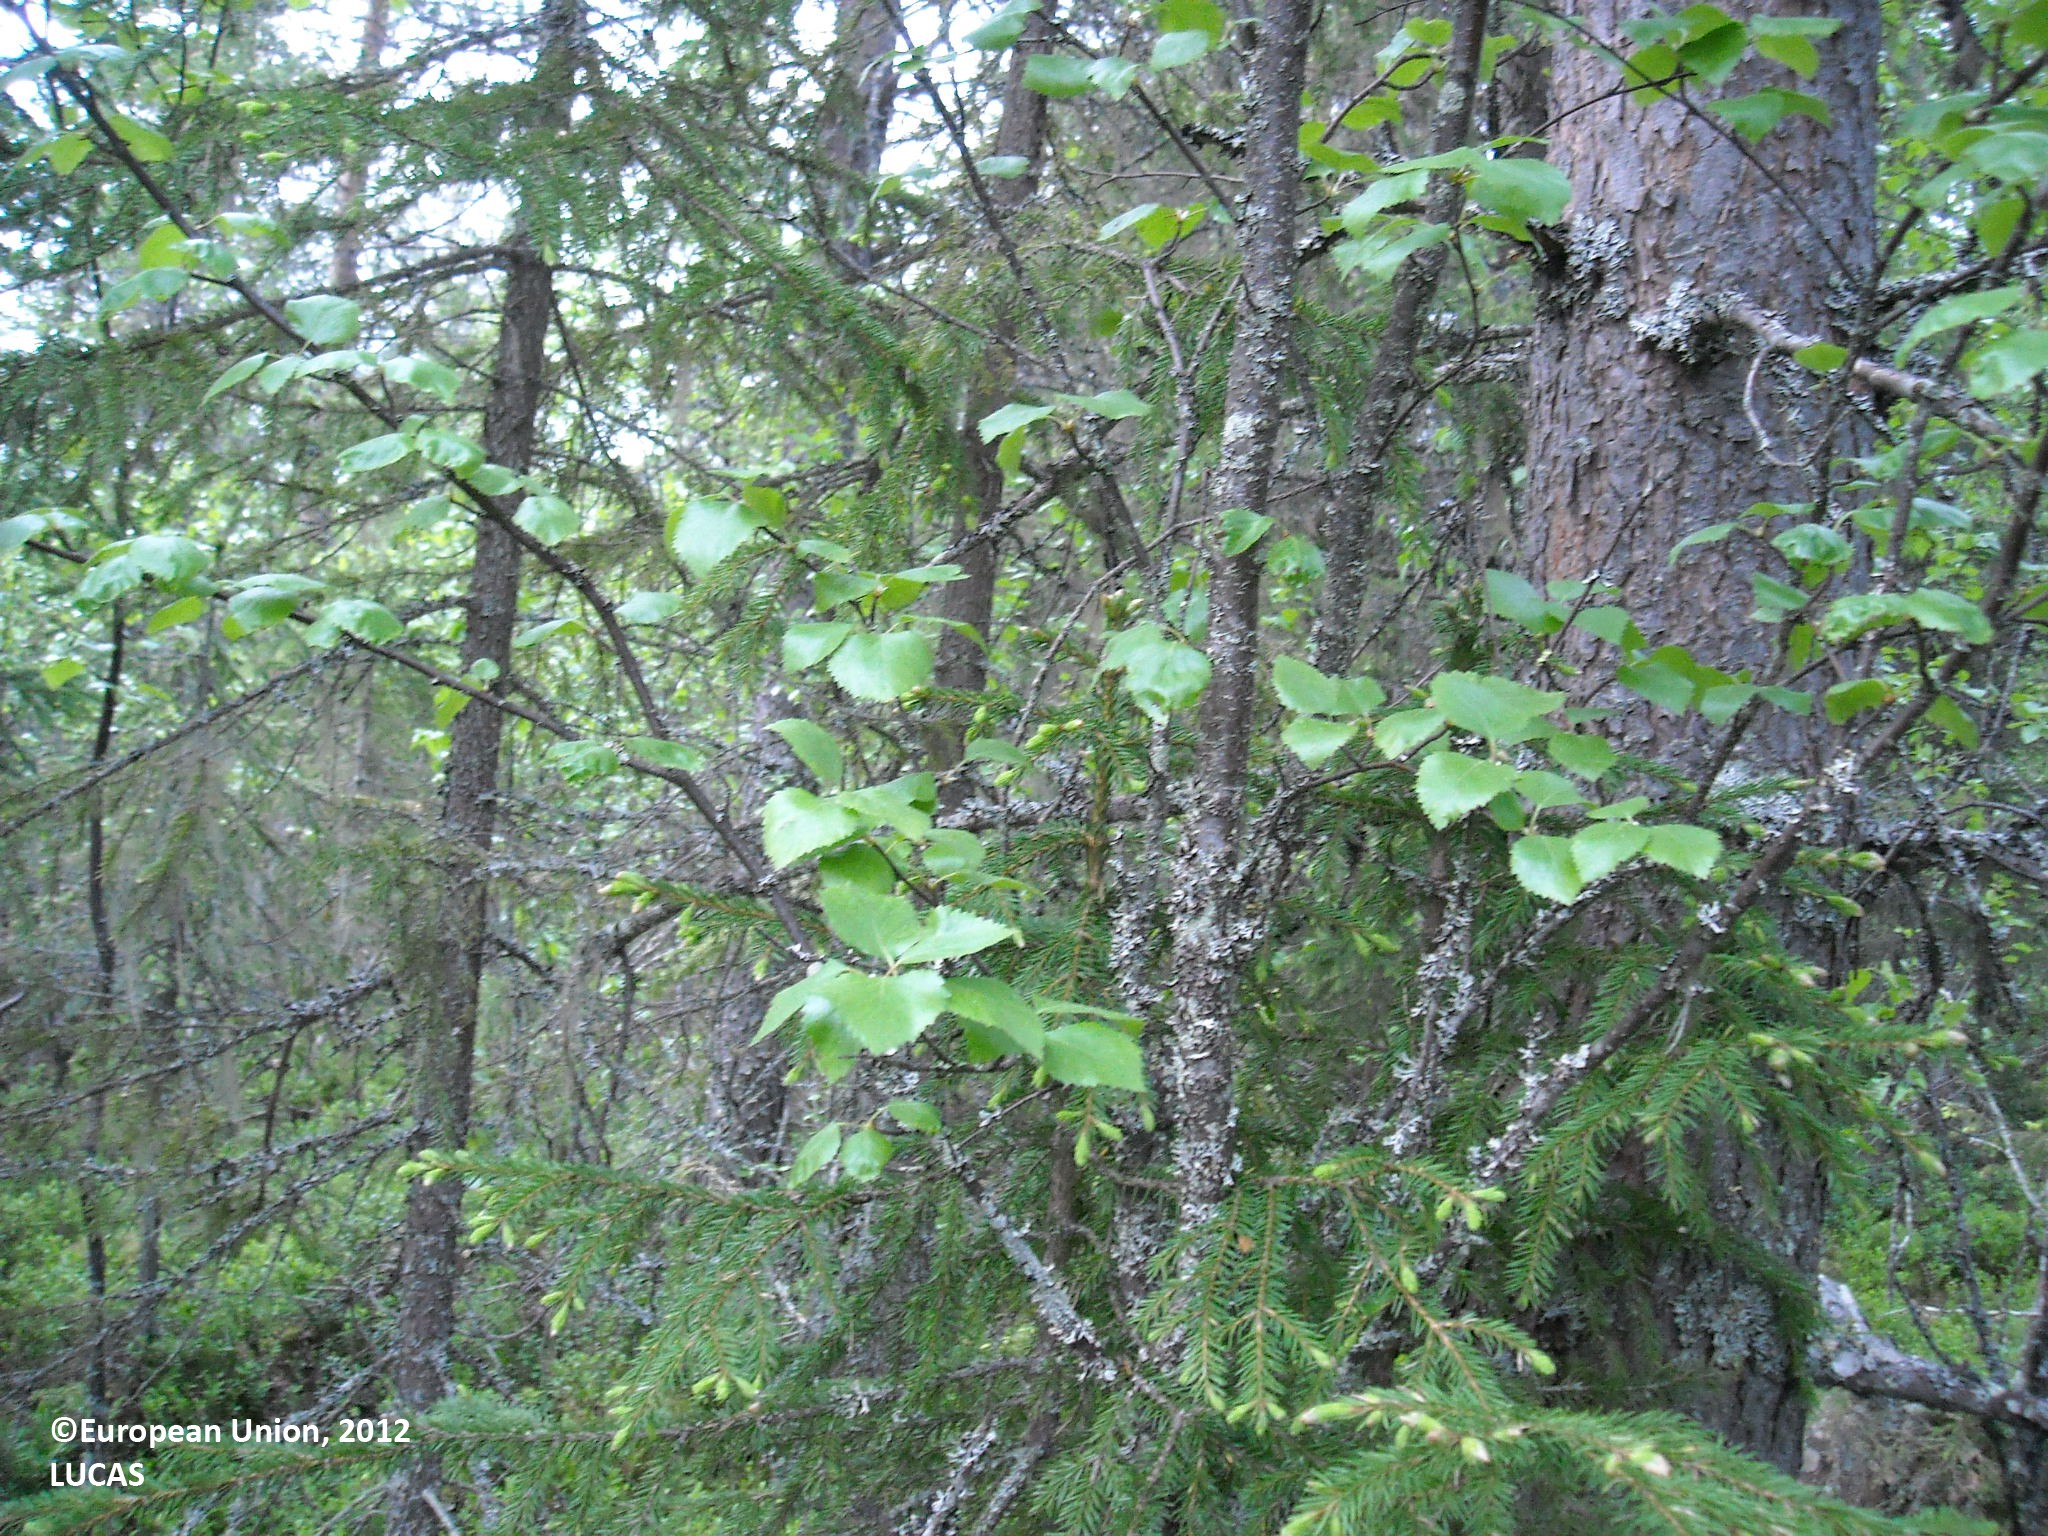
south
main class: Woodland
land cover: Other mixed woodland
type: boreal forest
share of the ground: > 75 %
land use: Forestry
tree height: > 5 m
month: June
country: FI
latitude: 65.6637
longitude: 28.0419
